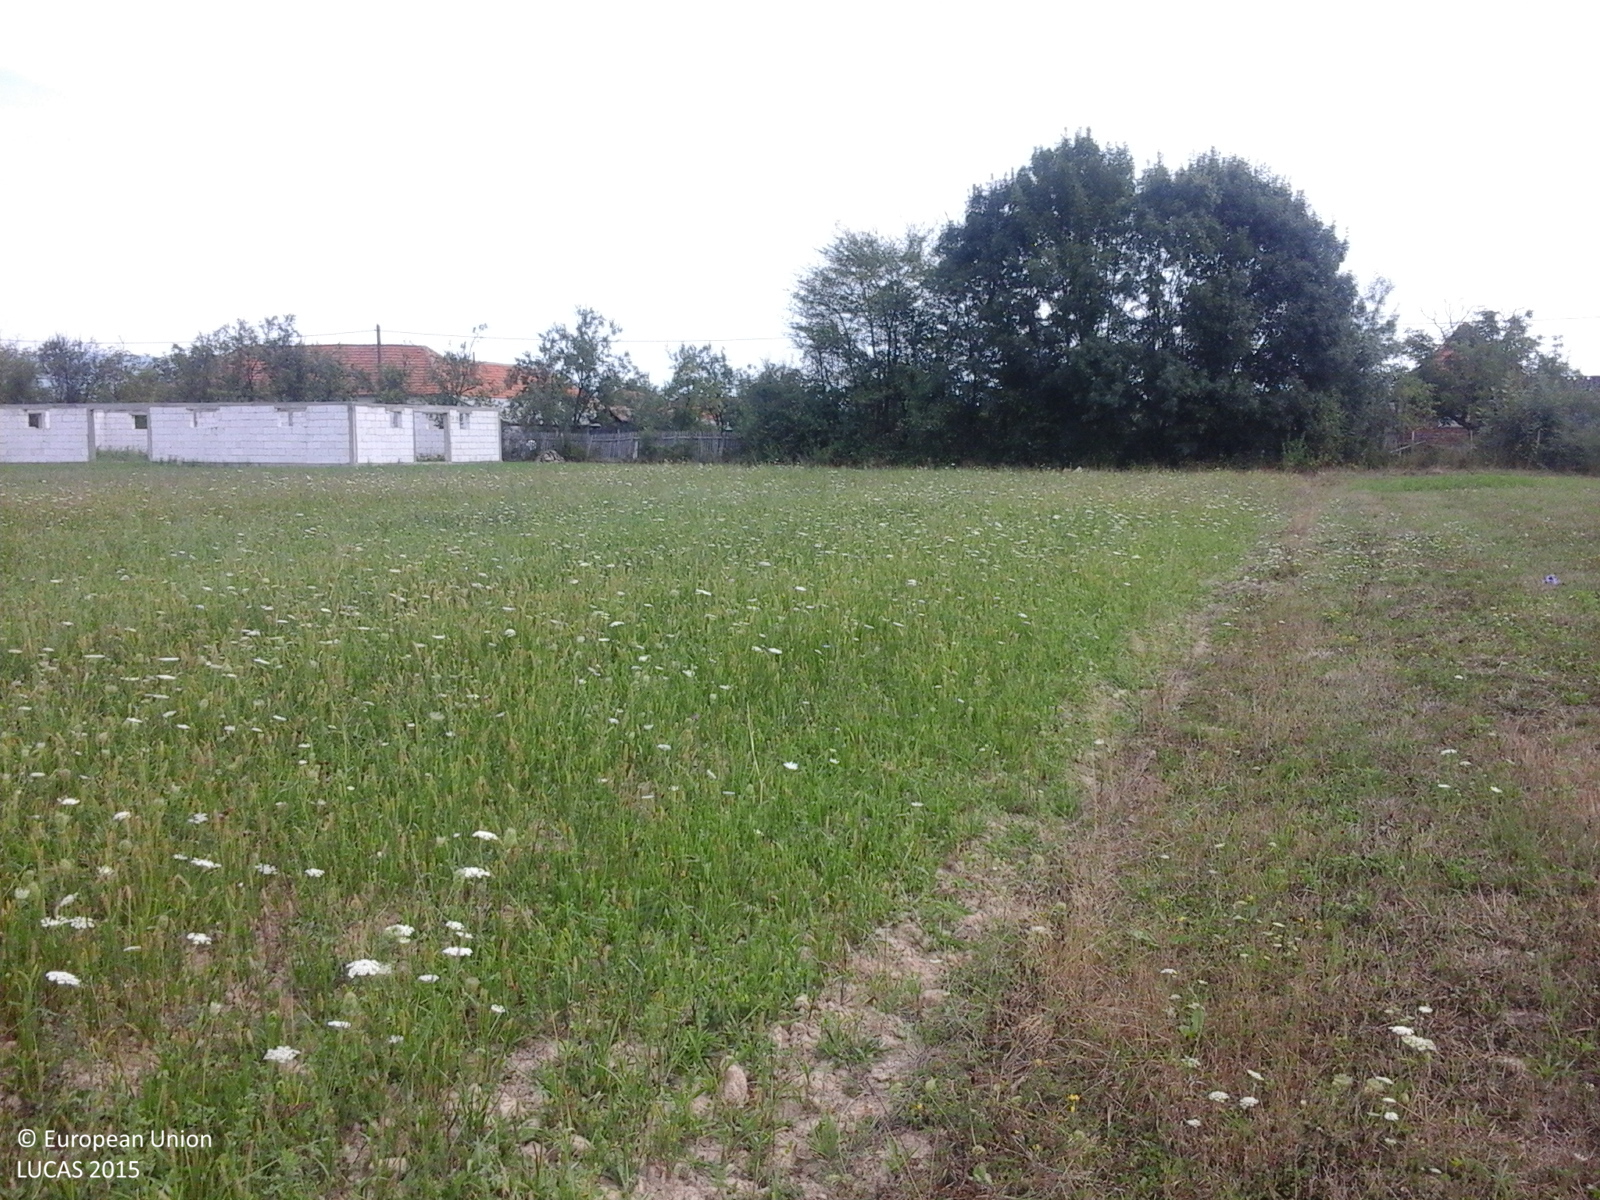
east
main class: Grassland
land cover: Grassland without tree/shrub cover
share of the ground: > 75 %
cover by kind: herbaceous plants 100 %
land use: Agriculture (excluding fallow land and kitchen gardens)
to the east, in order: Grassland without tree/shrub cover; Lines of trees; Other fruit trees and berries; Paved roads, cycling and walking lanes; Electric lines; Grassland without tree/shrub cover; Fences; Other fruit trees and berries; Fences; Arable land (only in case pi); Single bushes/trees; Arable land (only in case pi); Single bushes/trees; Arable land (only in case pi); Lines of trees; Arable land (only in case pi); Fences; Grassland without tree/shrub cover
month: August
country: RO
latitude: 46.3188
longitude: 22.2416
